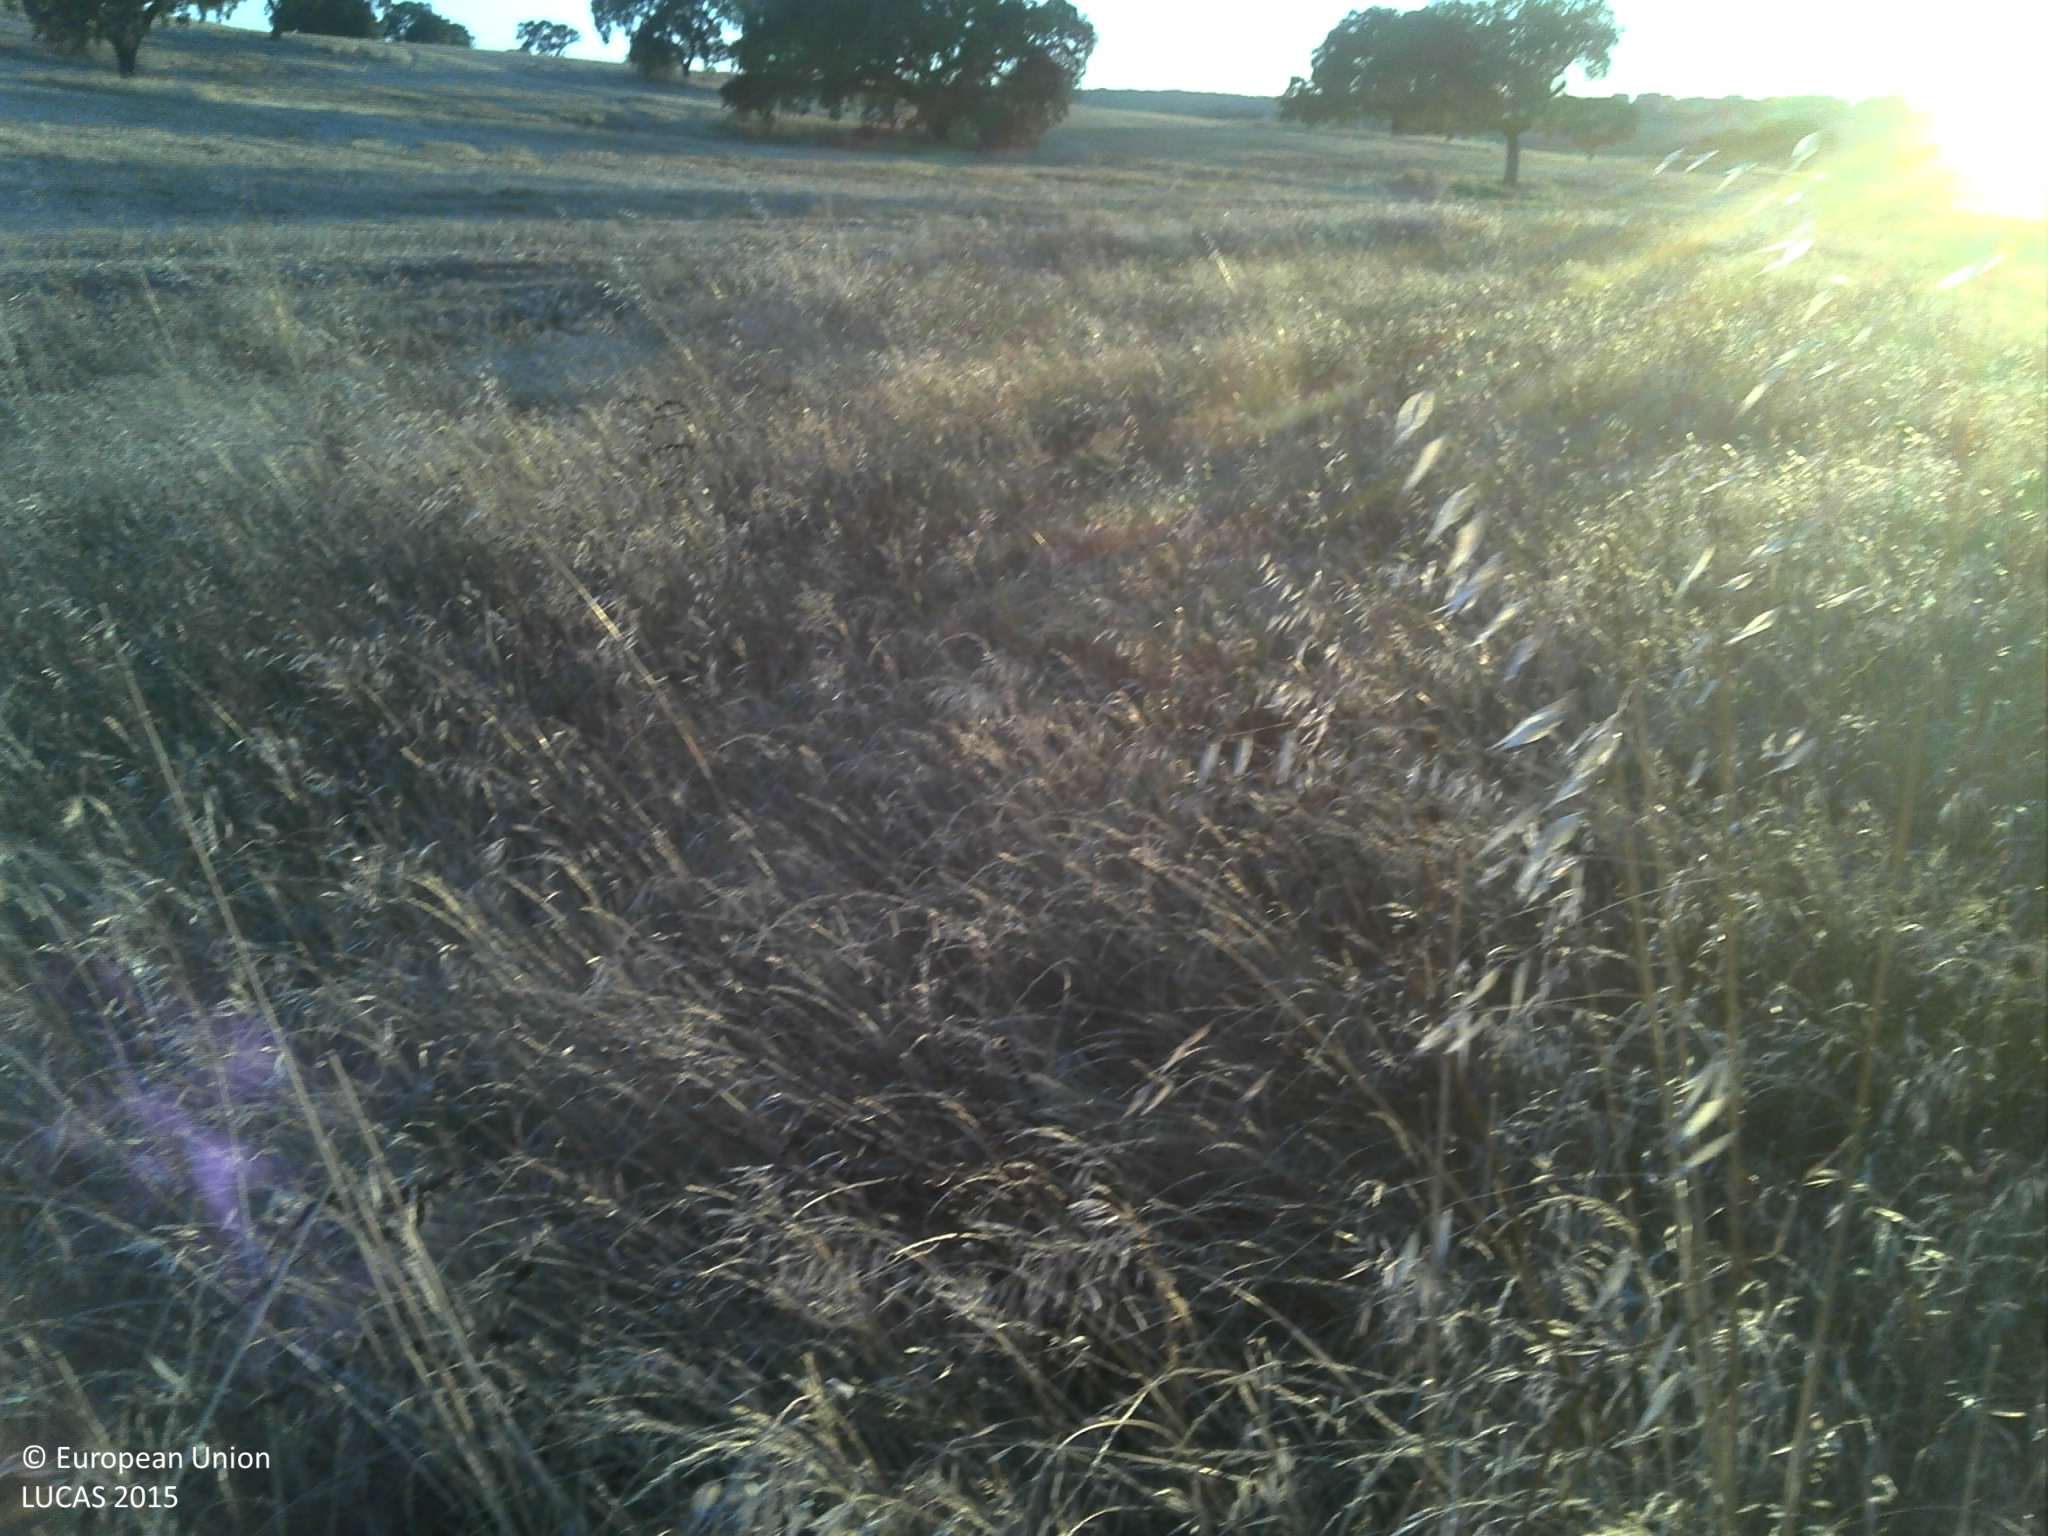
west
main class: Grassland
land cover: Grassland without tree/shrub cover
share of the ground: > 75 %
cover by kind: herbaceous plants 100 %
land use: Agriculture (excluding fallow land and kitchen gardens)
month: July
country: PT
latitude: 37.8440
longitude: -8.0169
